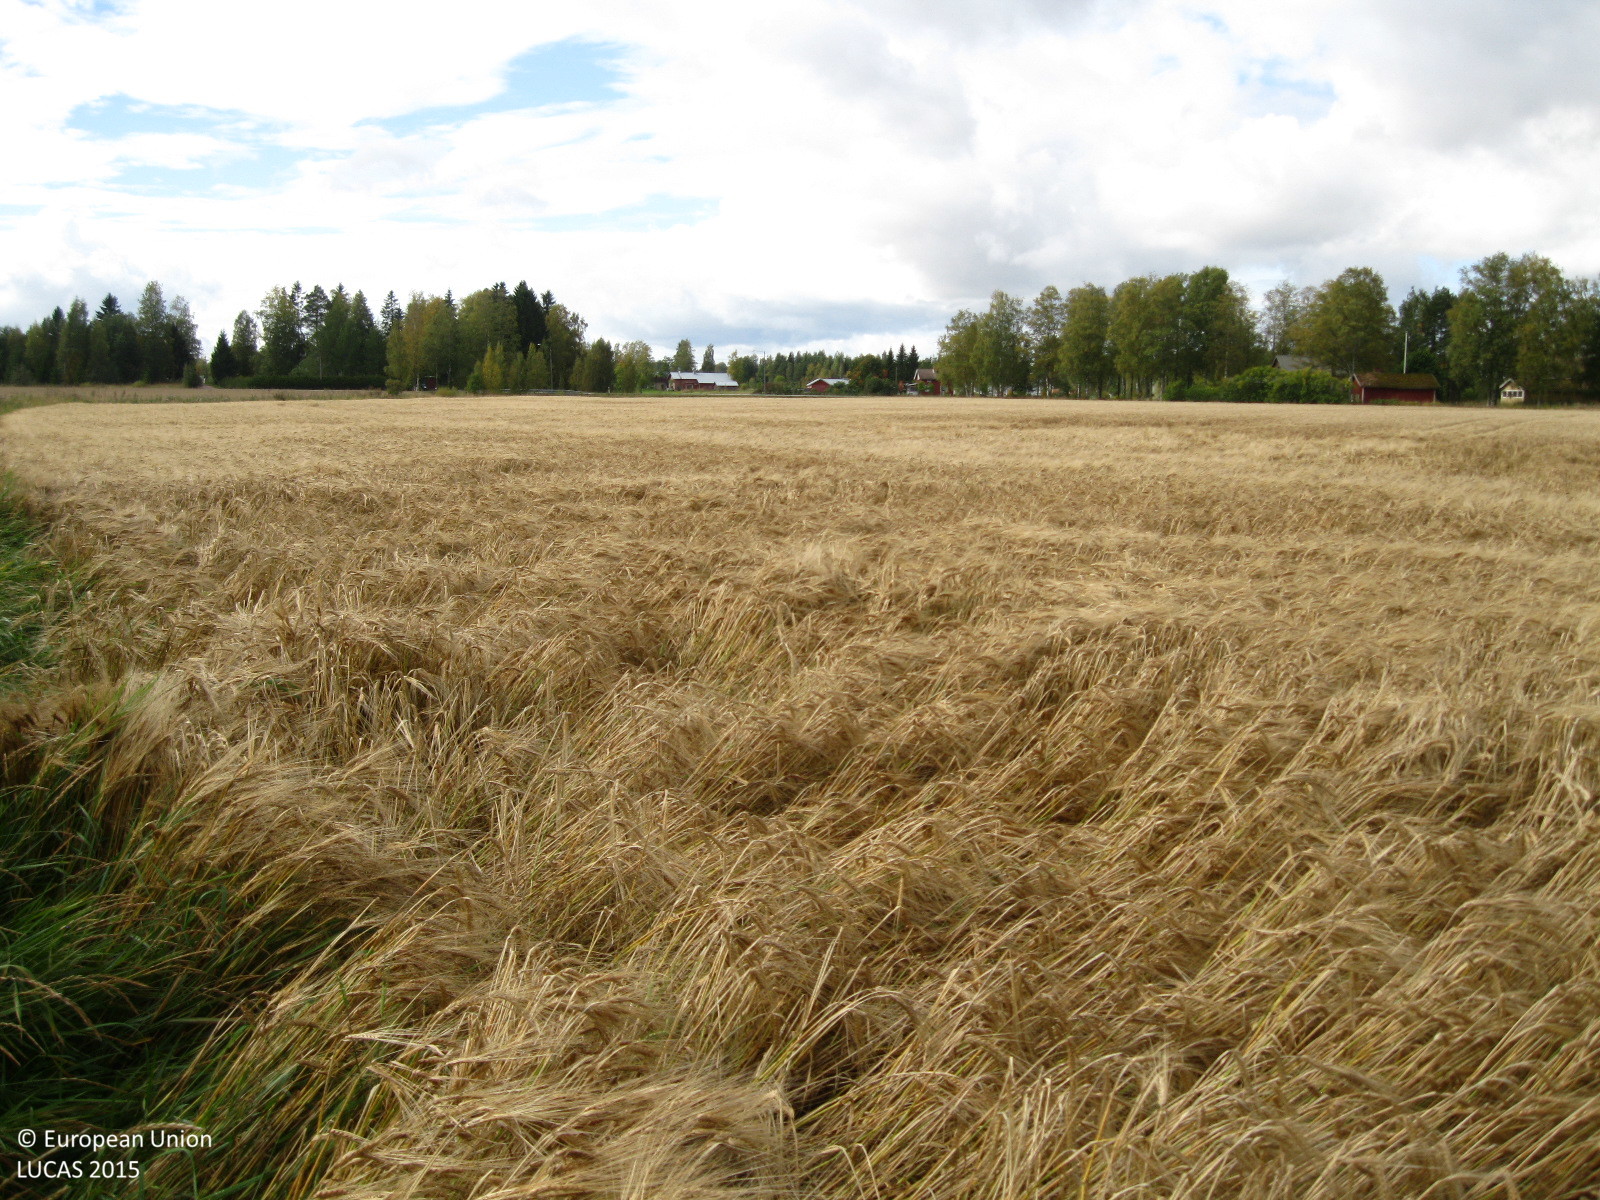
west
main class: Cropland
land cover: Barley
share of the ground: > 75 %
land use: Agriculture (excluding fallow land and kitchen gardens)
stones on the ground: < 10 %
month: September
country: FI
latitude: 60.7772
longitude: 24.7444
